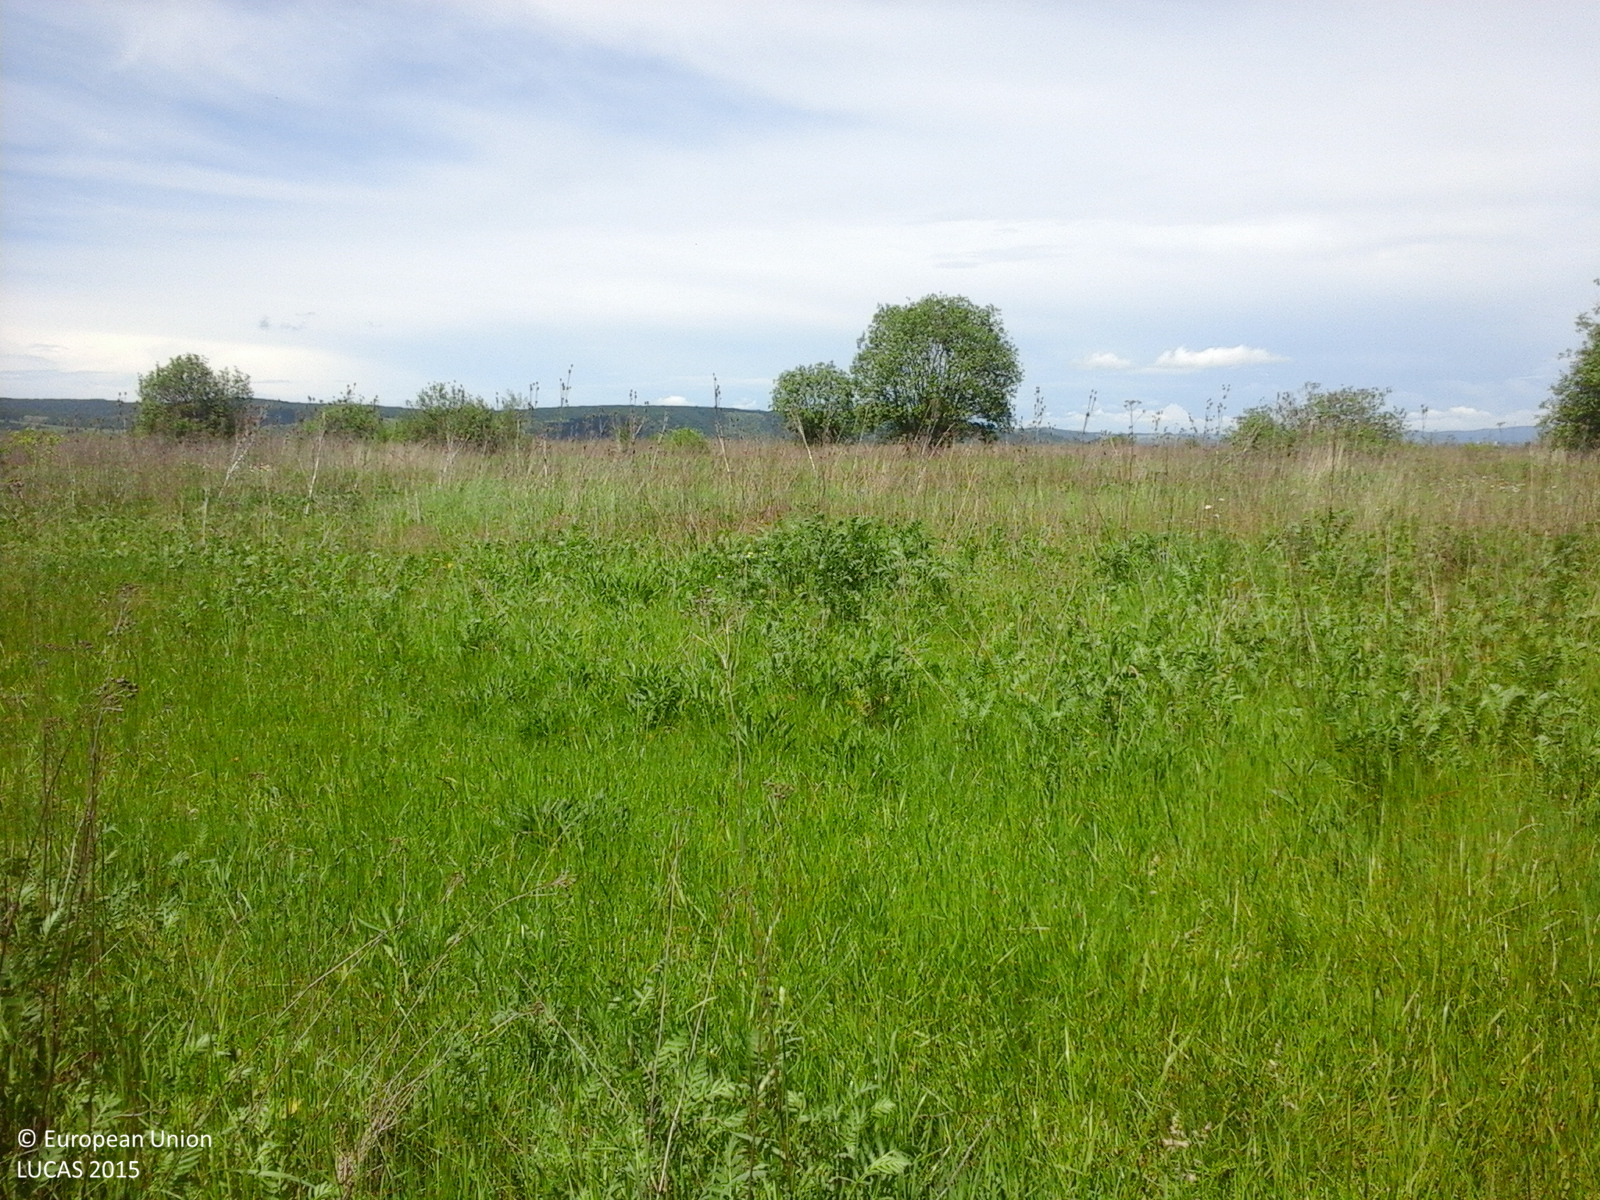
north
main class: Grassland
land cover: Spontaneously vegetated surfaces
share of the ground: > 75 %
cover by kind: herbaceous plants 100 %
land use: Fallow land
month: May
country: RO
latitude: 45.8466
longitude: 25.1752
